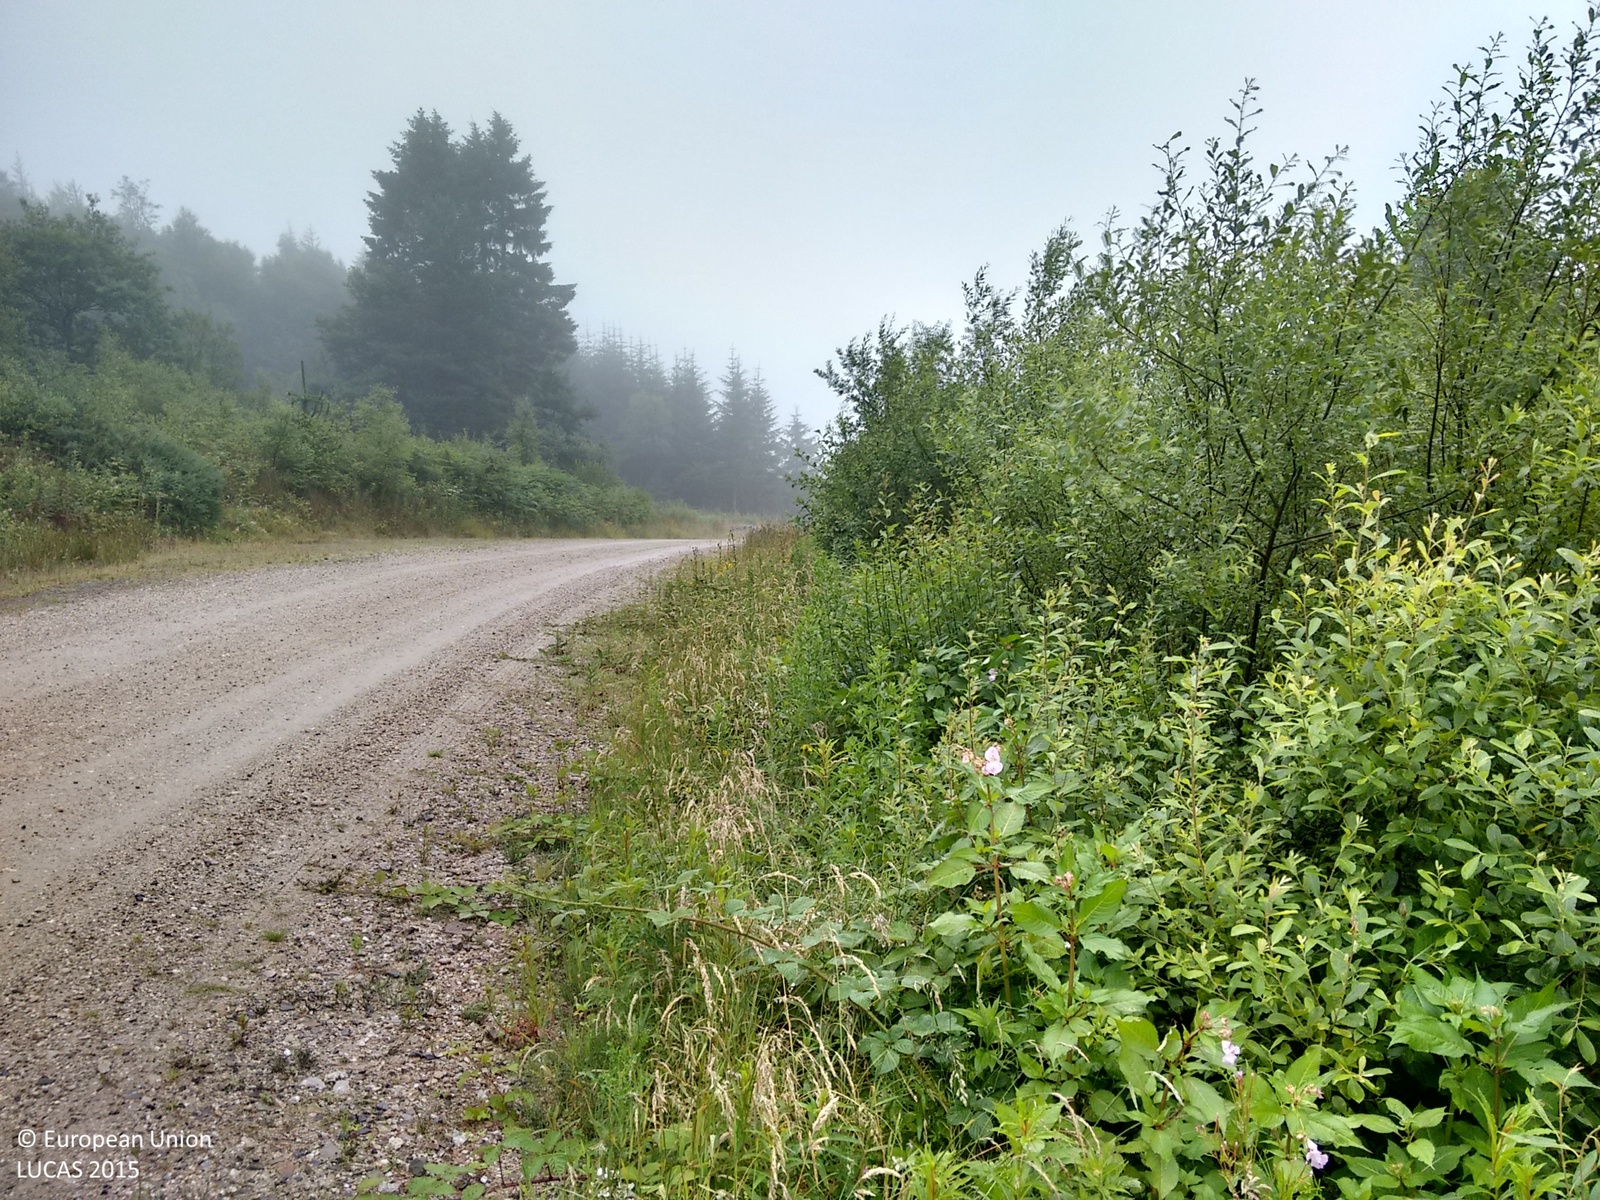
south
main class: Shrubland
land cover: Shrubland with sparse tree cover
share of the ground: > 75 %
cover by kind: shrubs 75 %, herbaceous plants 20 %, coniferous forest trees 5 %
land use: Forestry
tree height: > 5 m
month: July
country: GB
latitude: 51.7195
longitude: -3.7395
